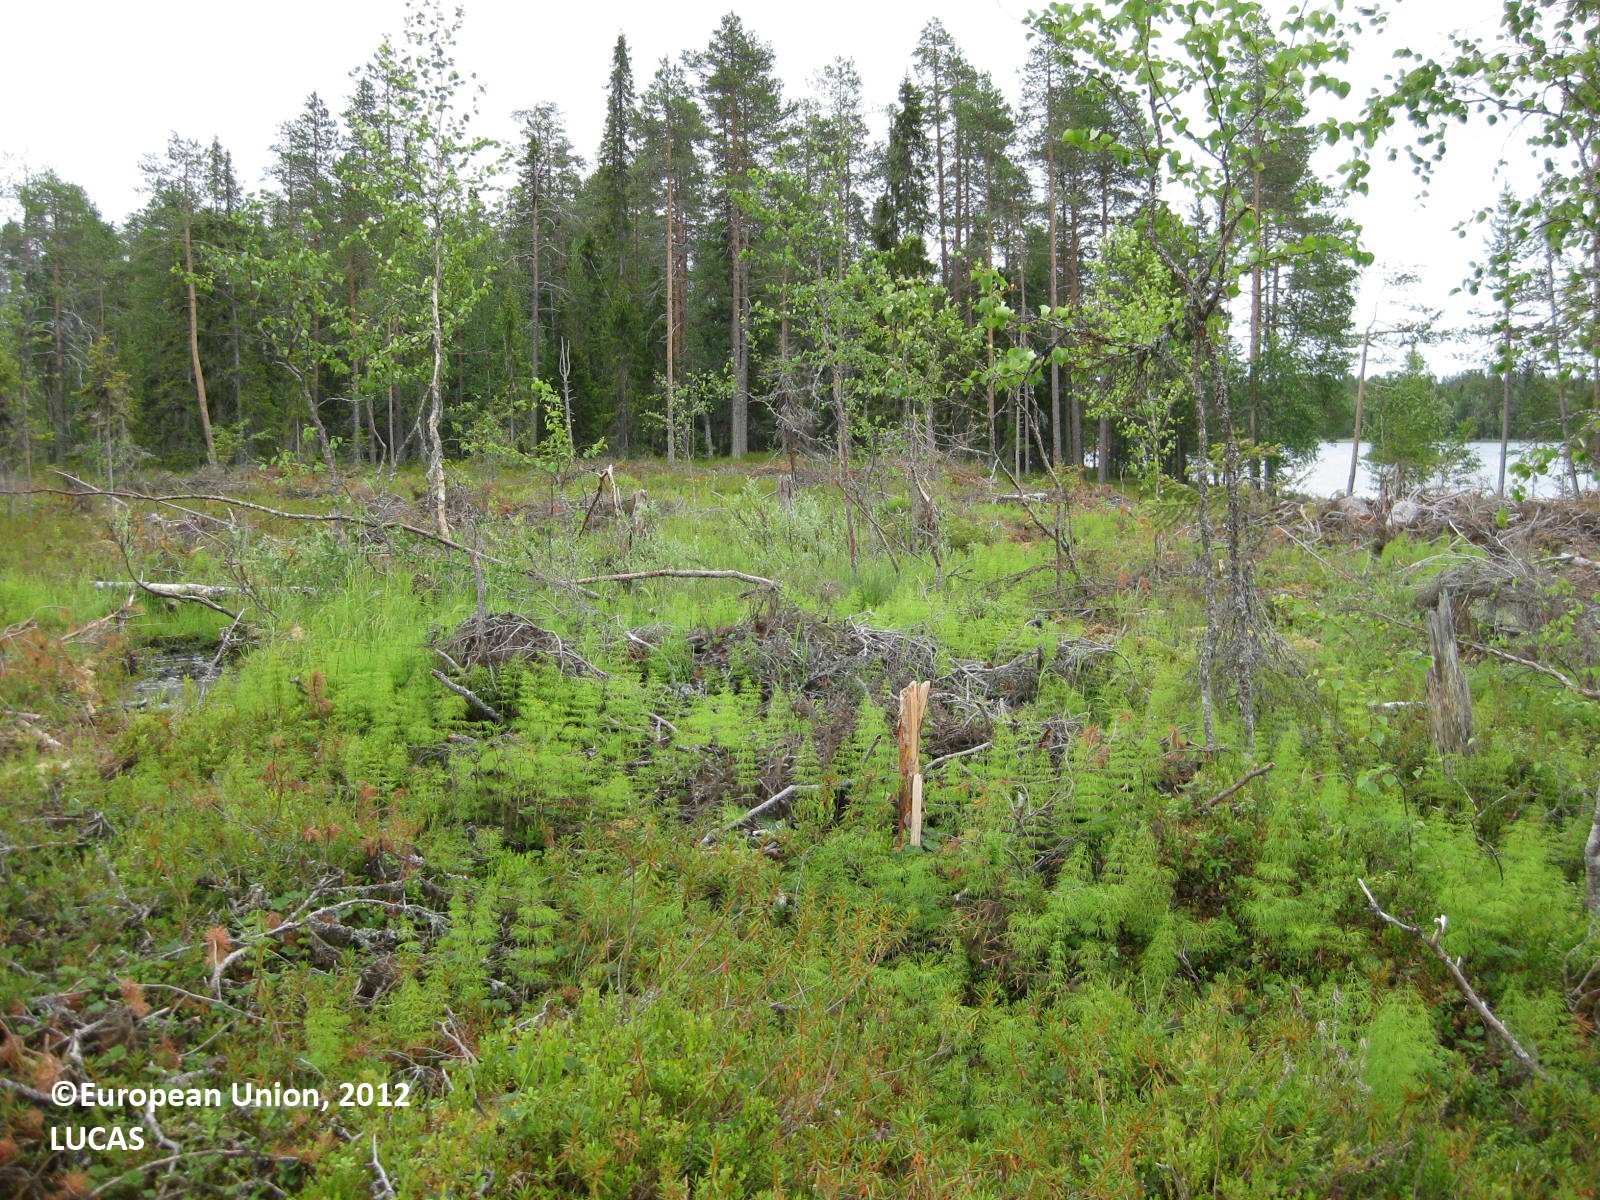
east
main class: Woodland
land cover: Broadleaved woodland
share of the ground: 10 - 25 %
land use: Forestry
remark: Clear cut
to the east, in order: Broadleaved woodland; Pine dominated coniferous woodland; Other coniferous woodland; Pine dominated coniferous woodland
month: July
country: FI
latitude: 65.8618
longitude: 29.7277
